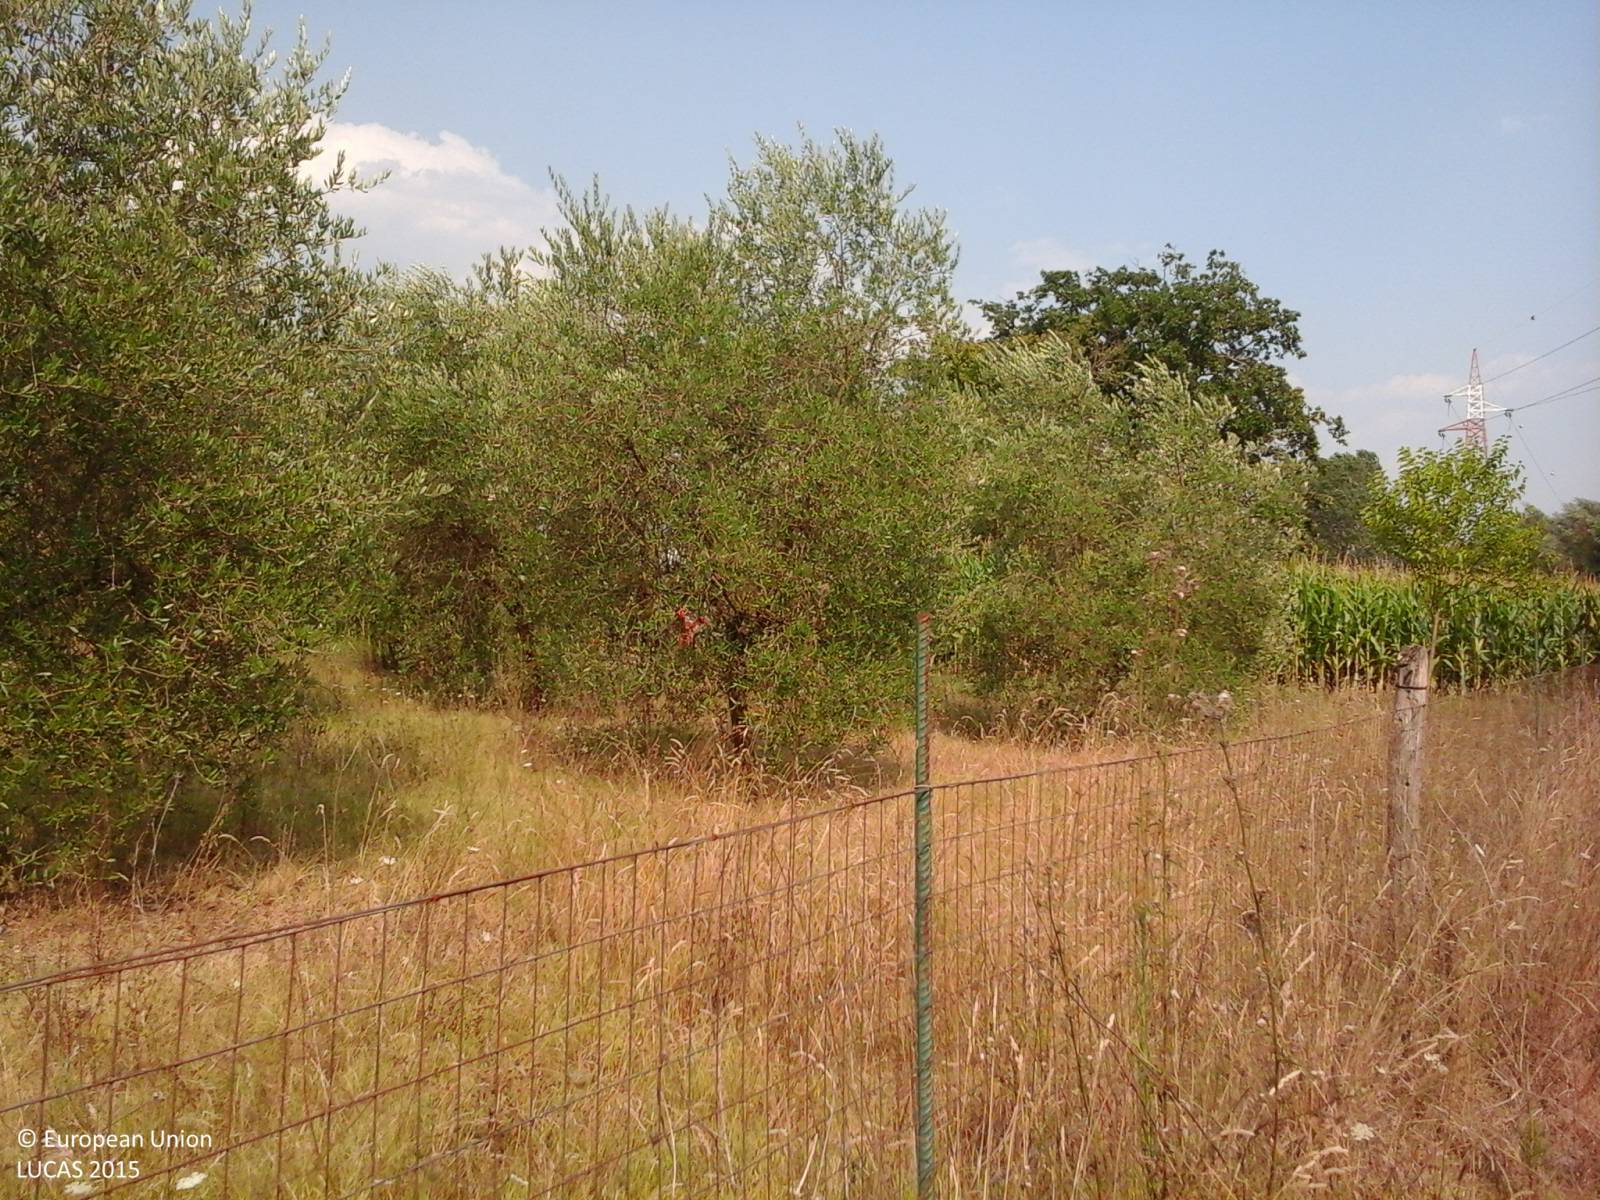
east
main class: Cropland
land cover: Olive groves
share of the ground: > 75 %
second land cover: Spontaneously vegetated surfaces
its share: > 75 %
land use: Agriculture (excluding fallow land and kitchen gardens)
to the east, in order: Olive groves; Spontaneously vegetated surfaces; Fences; Single bushes/trees; Spontaneously vegetated surfaces; Single bushes/trees; Maize; Grass margins; Temporary grasslands
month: August
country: IT
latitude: 41.4629
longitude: 13.7571
